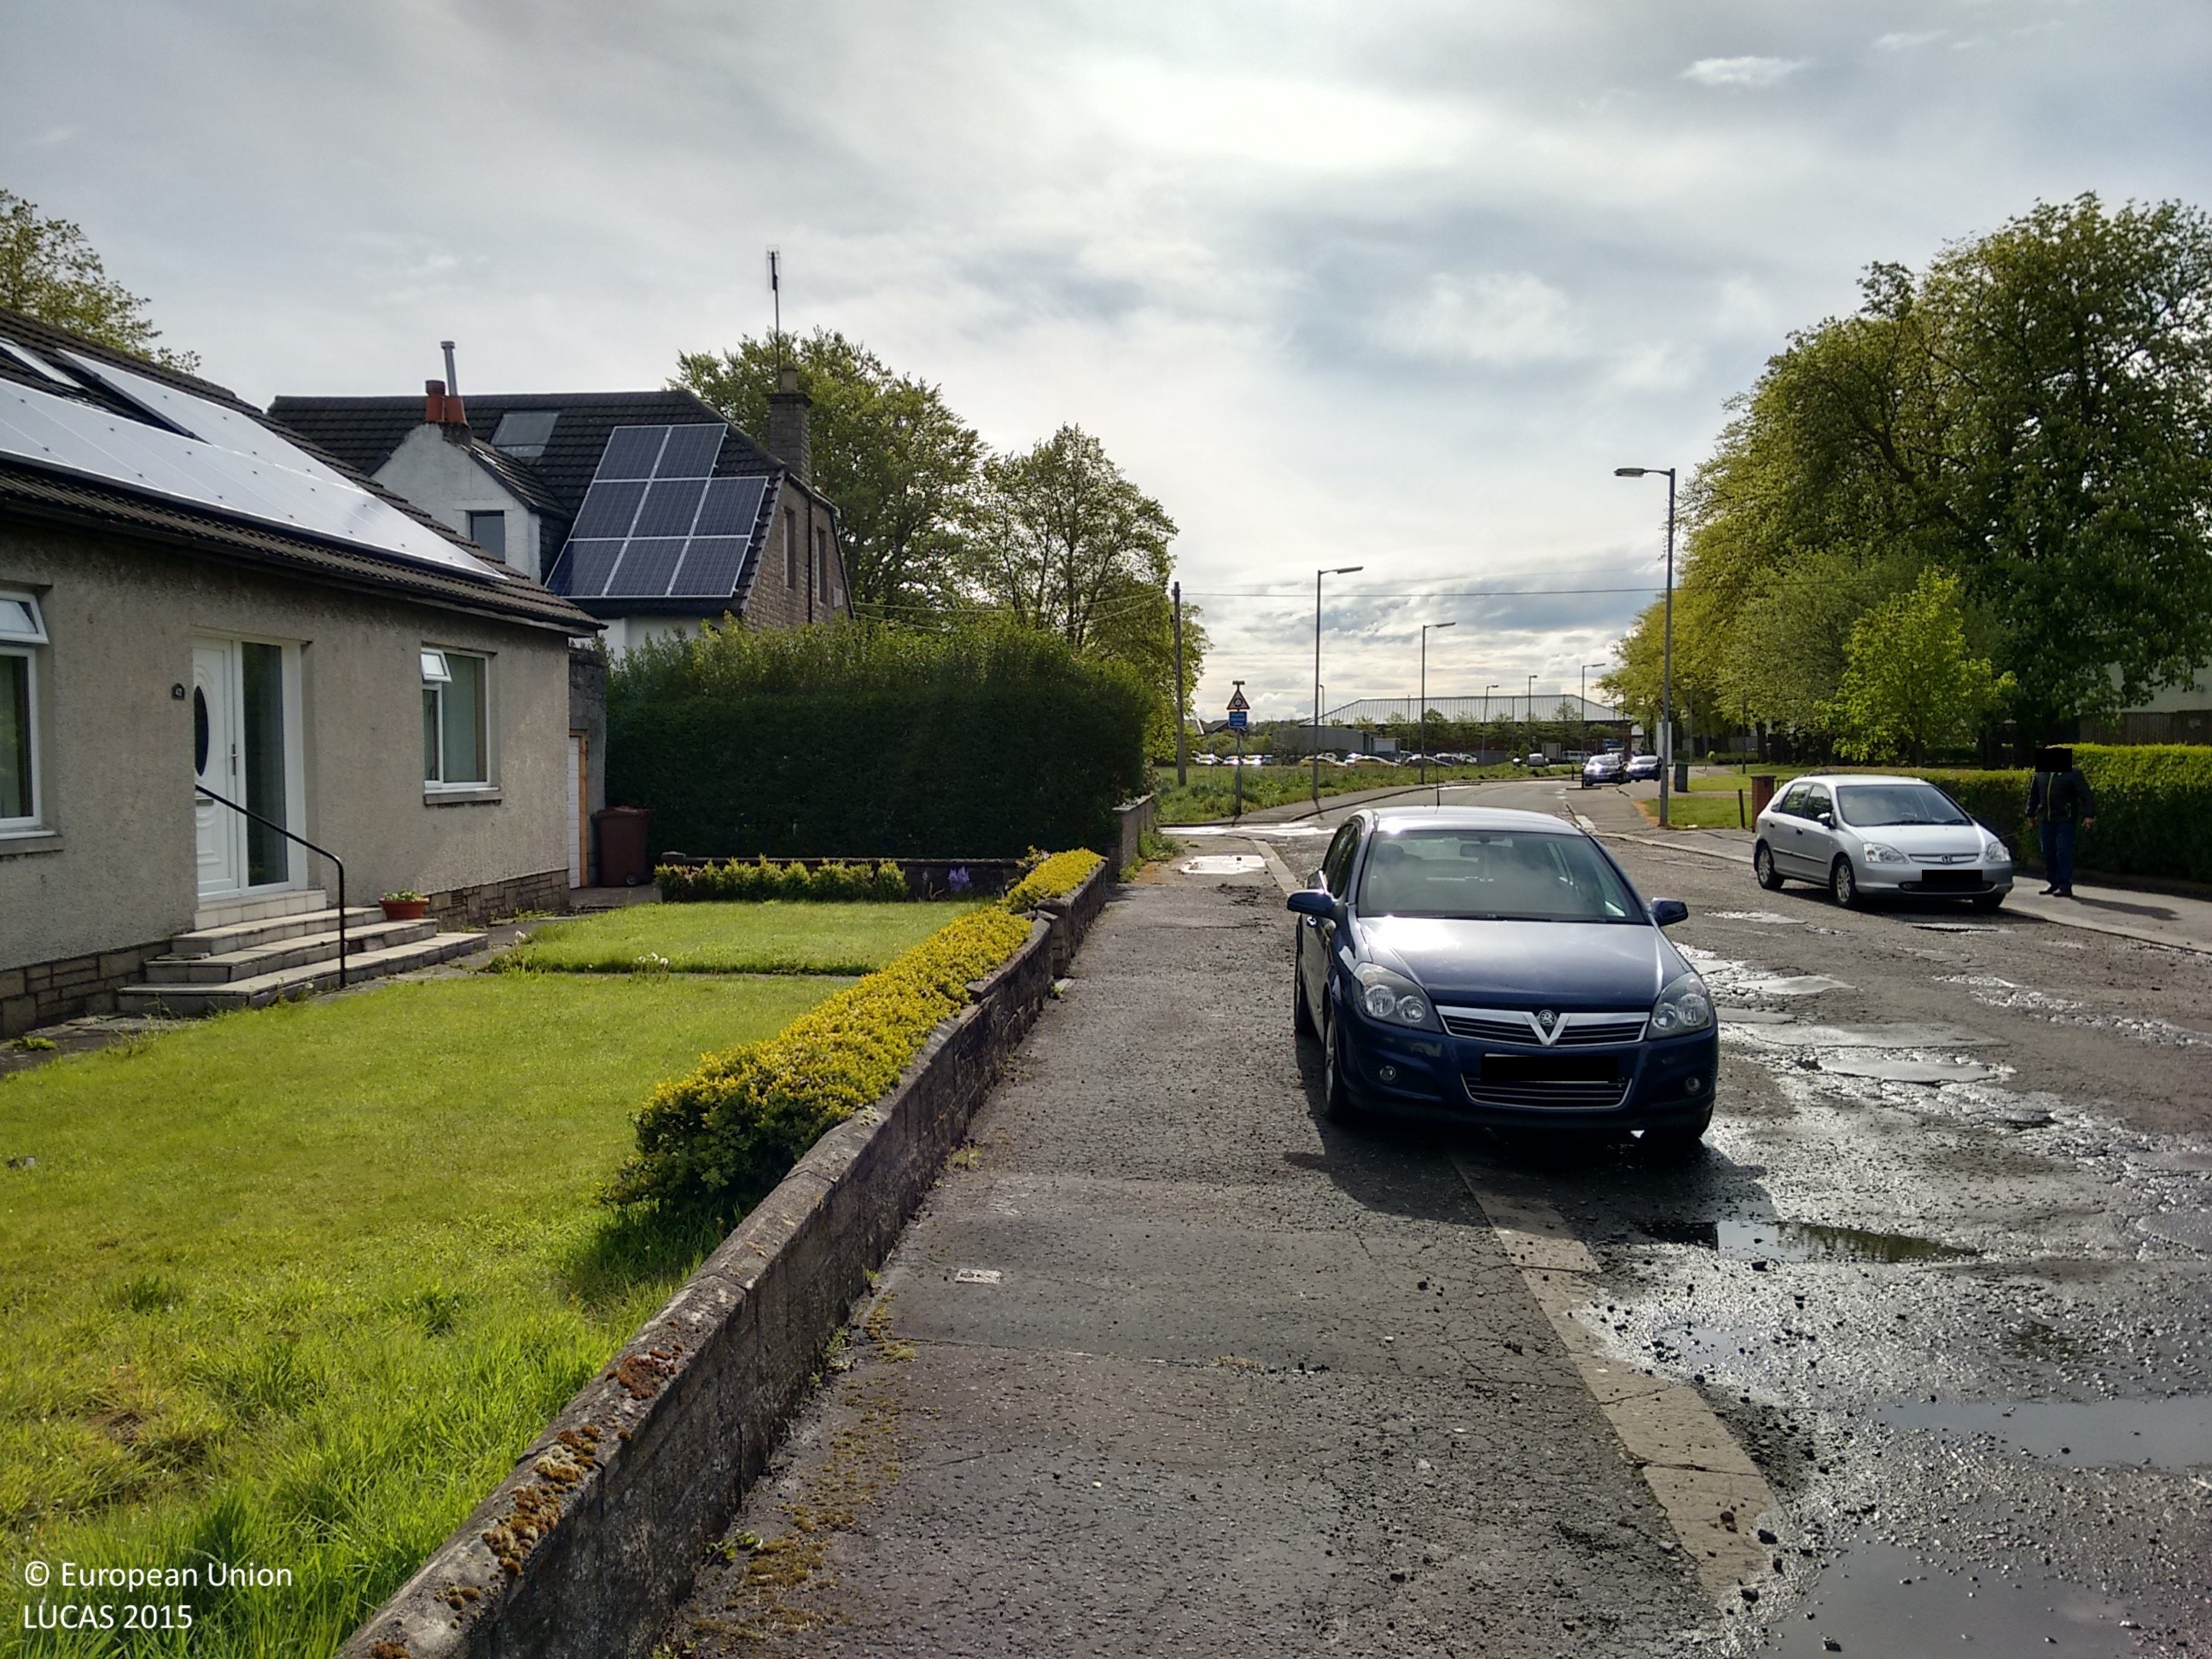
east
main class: Grassland
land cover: Grassland without tree/shrub cover
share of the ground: > 75 %
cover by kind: herbaceous plants 100 %
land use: Residential
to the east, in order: Grassland without tree/shrub cover; Broadleaved woodland; Artificial constructions in urban areas; Grassland without tree/shrub cover; Broadleaved woodland; Grassland without tree/shrub cover; Artificial constructions in urban areas
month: May
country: GB
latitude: 55.8603
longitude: -4.4286
